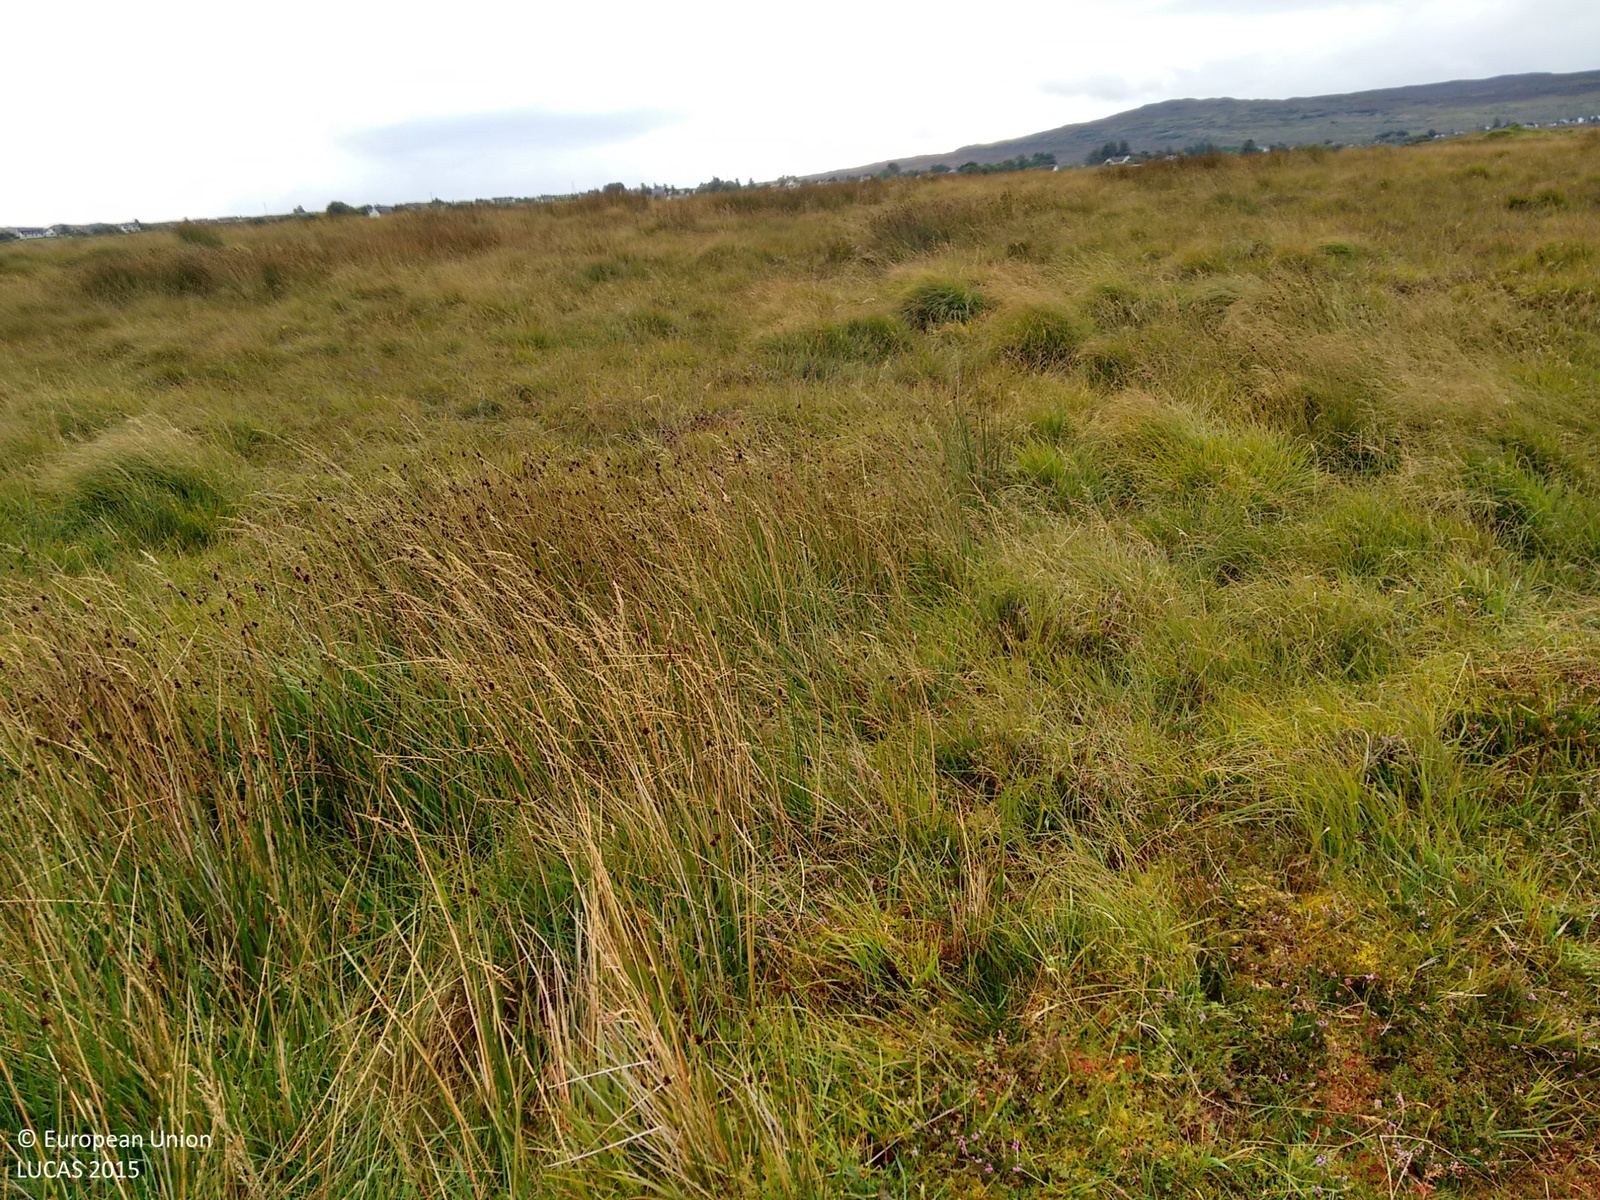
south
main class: Grassland
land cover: Grassland without tree/shrub cover
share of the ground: > 75 %
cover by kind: herbaceous plants 95 %, shrubs 5 %
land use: Agriculture (excluding fallow land and kitchen gardens)
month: September
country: GB
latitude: 57.2507
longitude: -5.8548
